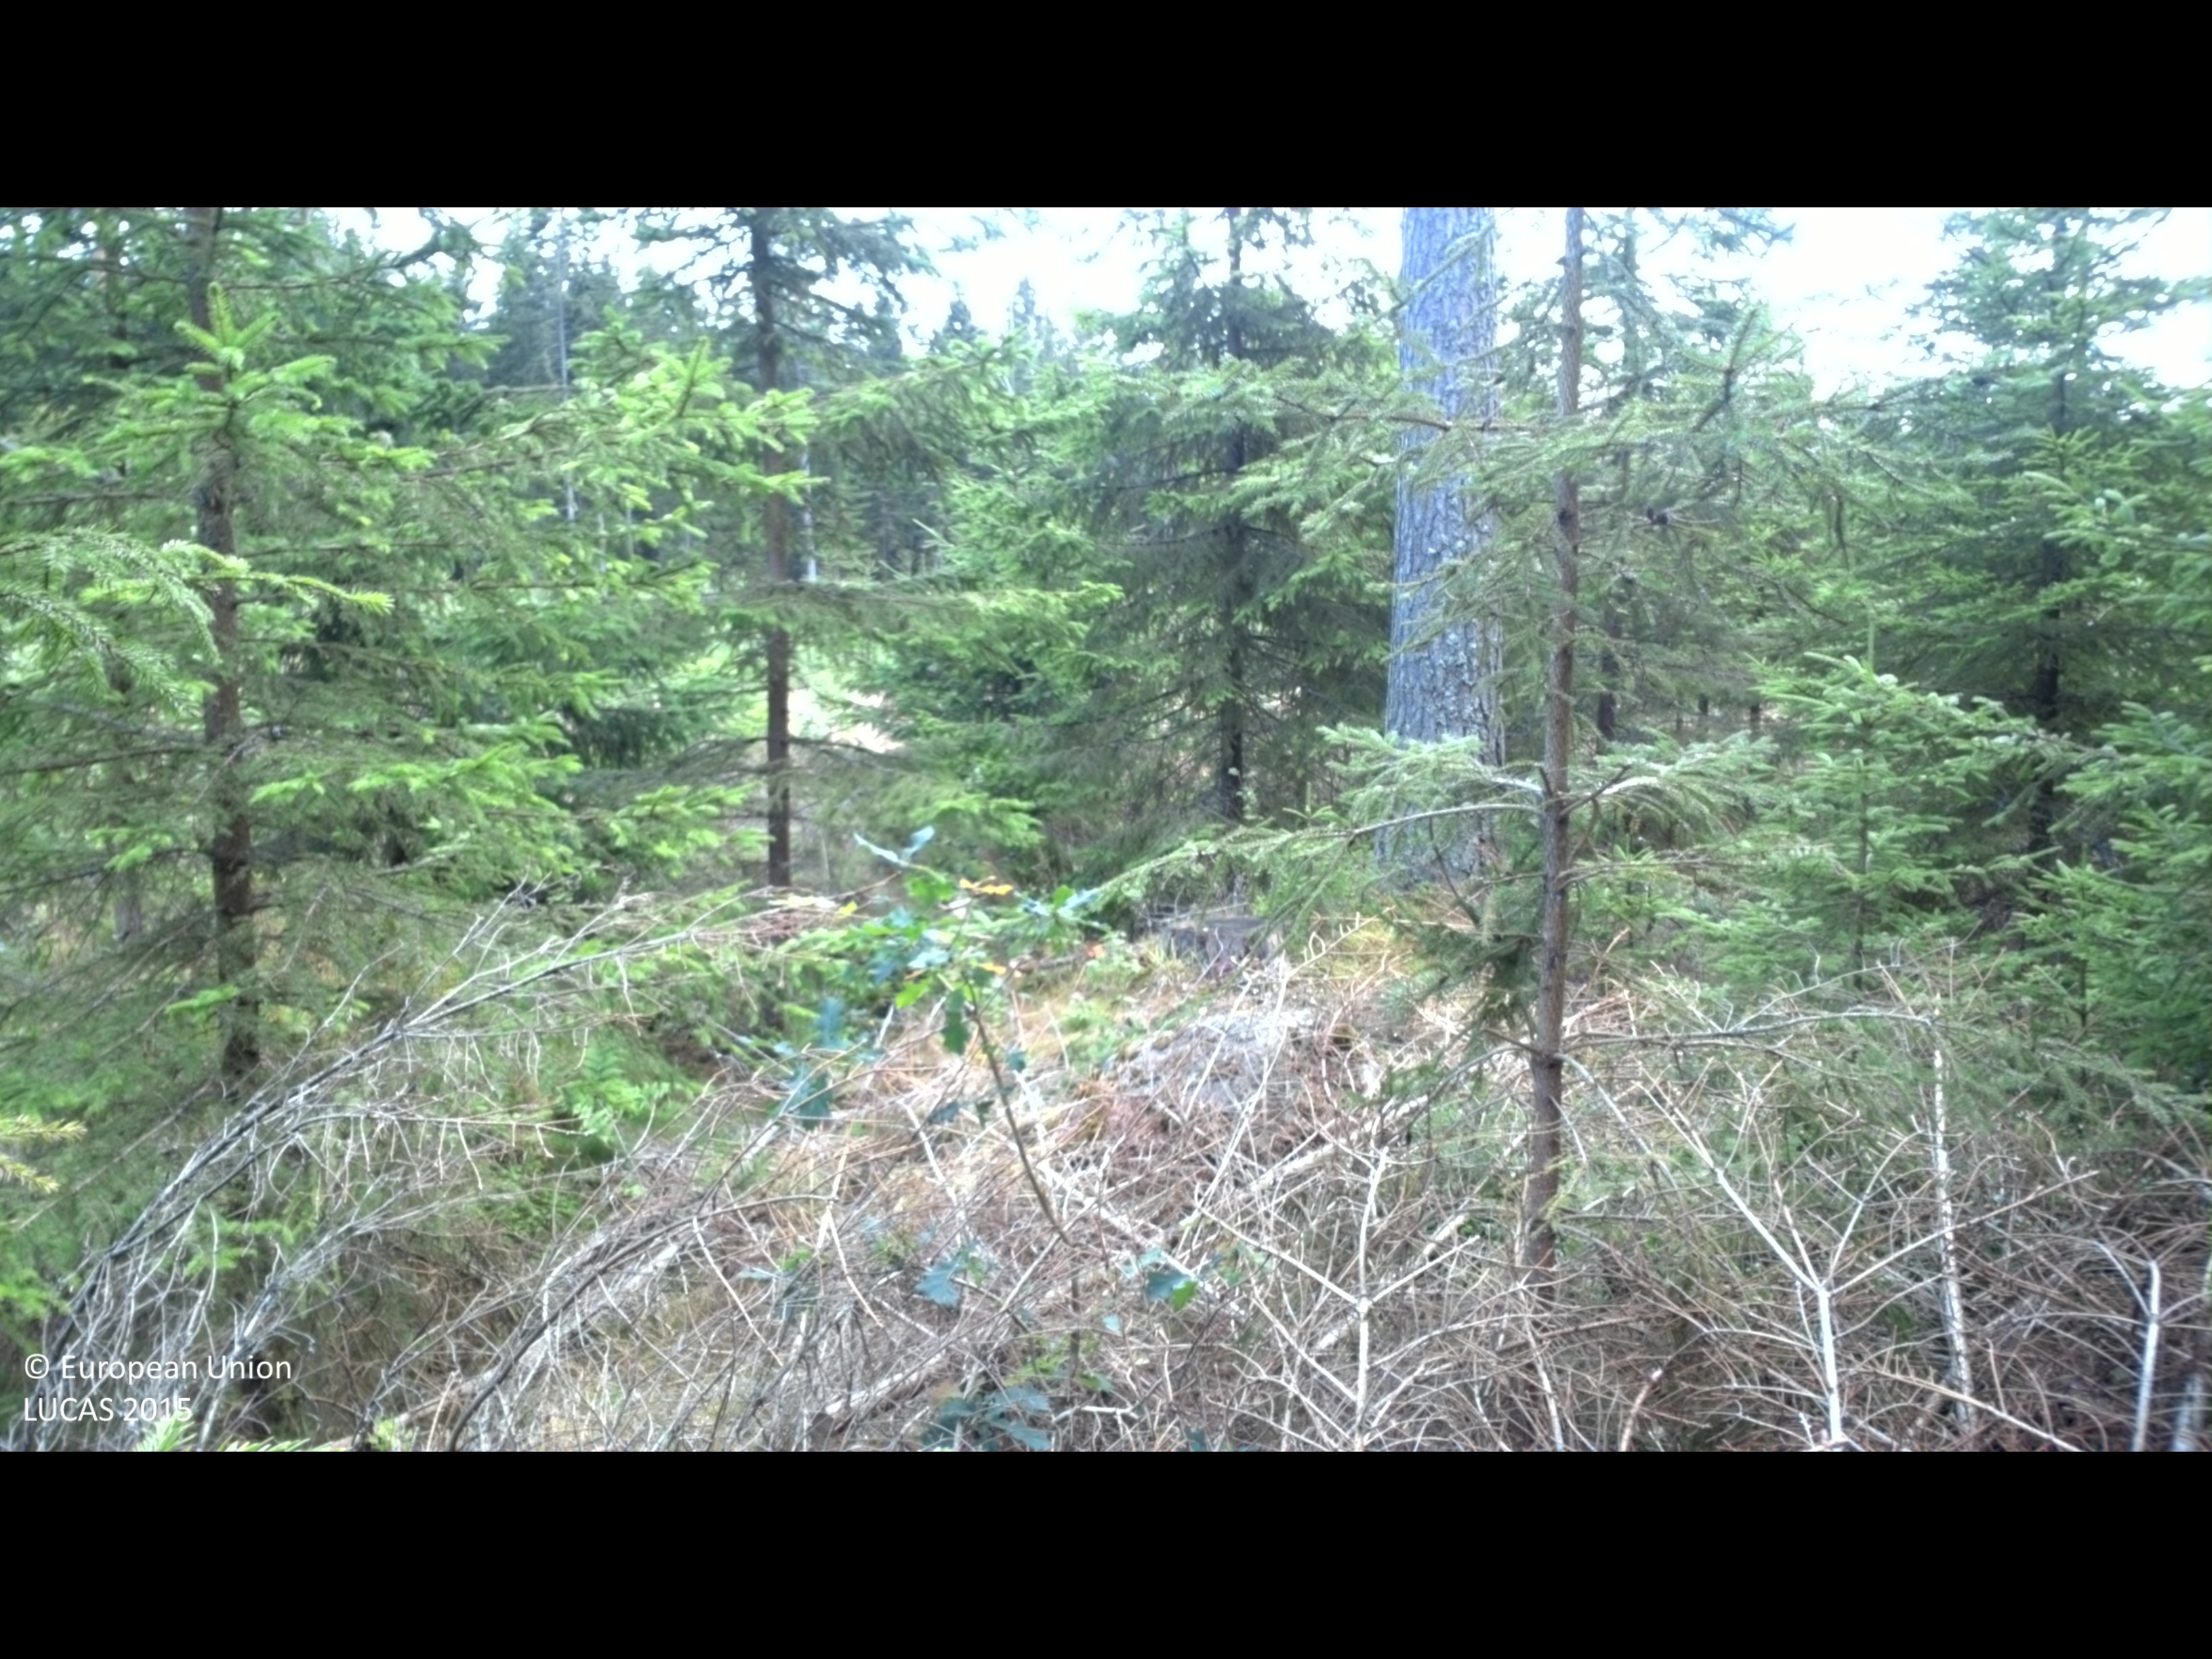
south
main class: Woodland
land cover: Spruce dominated coniferous woodland
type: boreal forest
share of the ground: 50 - 75 %
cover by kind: coniferous forest trees 75 %, lichens and mosses 20 %, shrubs 5 %
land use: Forestry
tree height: > 5 m
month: July
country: SE
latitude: 56.4039
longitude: 14.8107
